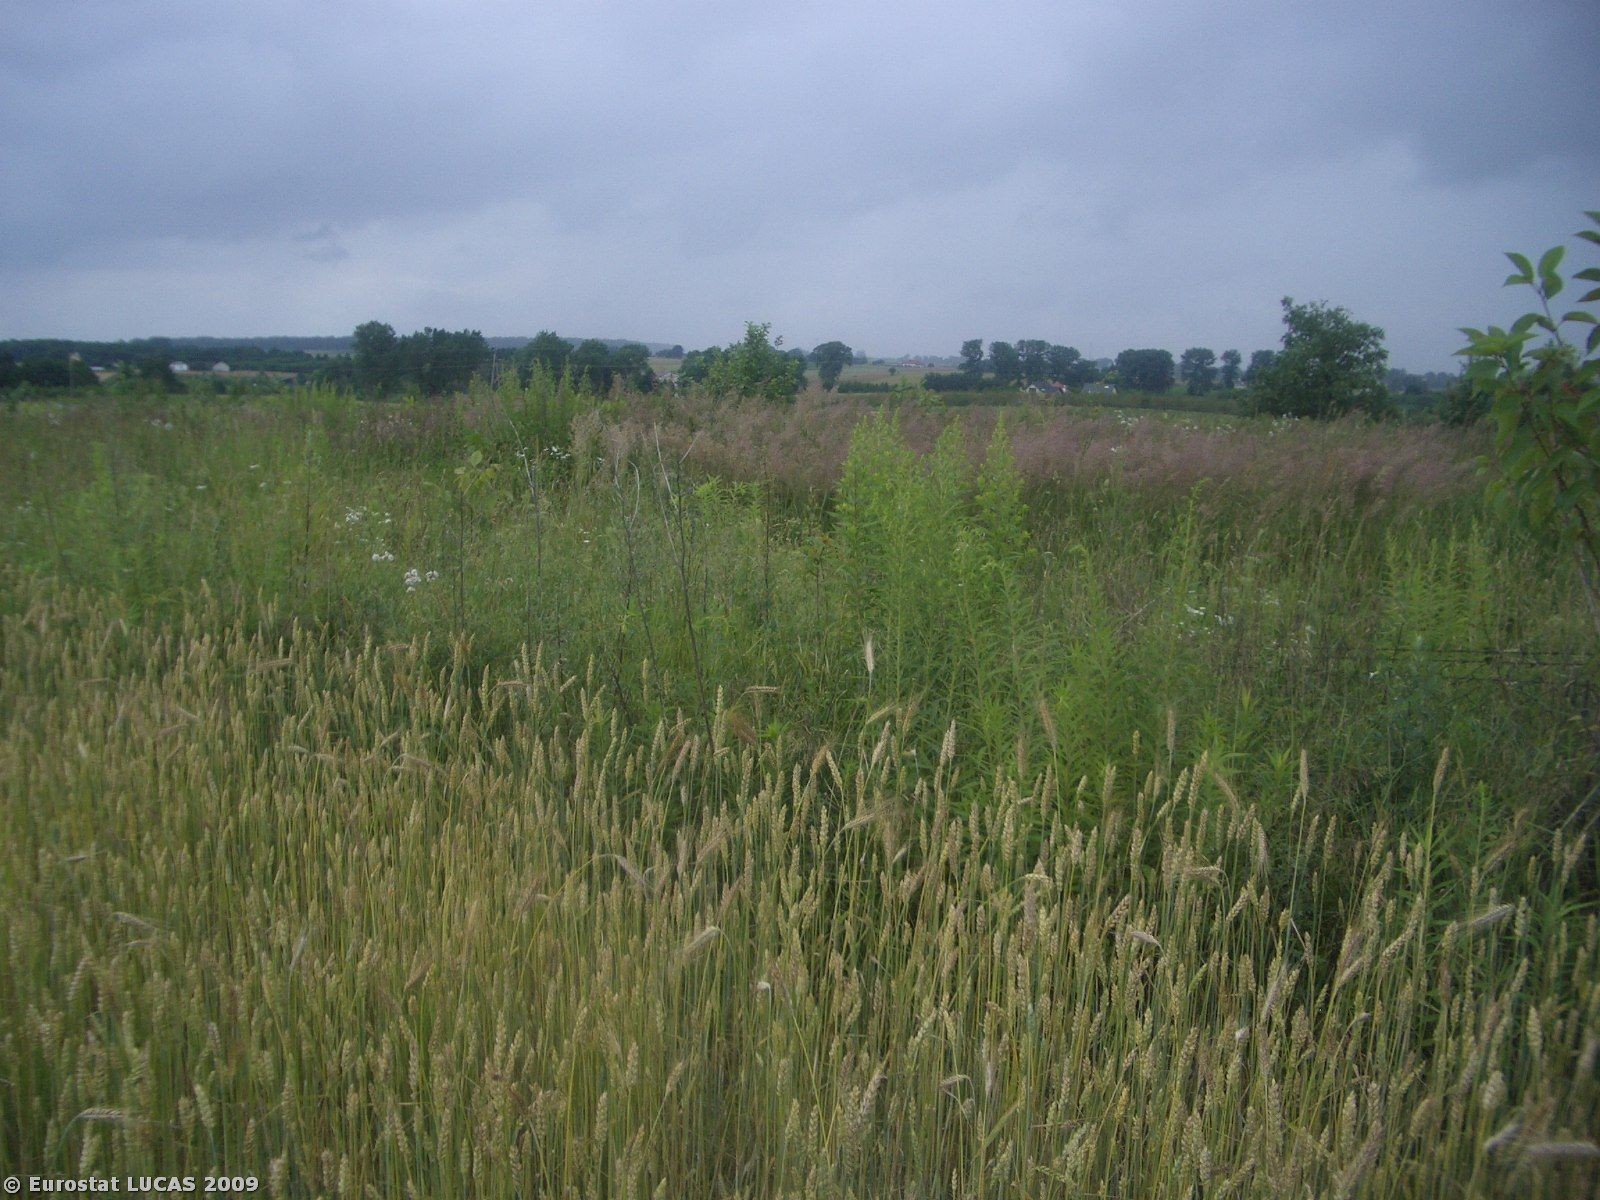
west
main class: Cropland
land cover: Triticale
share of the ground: 25 - 50 %
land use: Agriculture (excluding fallow land and kitchen gardens)
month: September
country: PL
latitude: 51.2717
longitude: 22.3771
